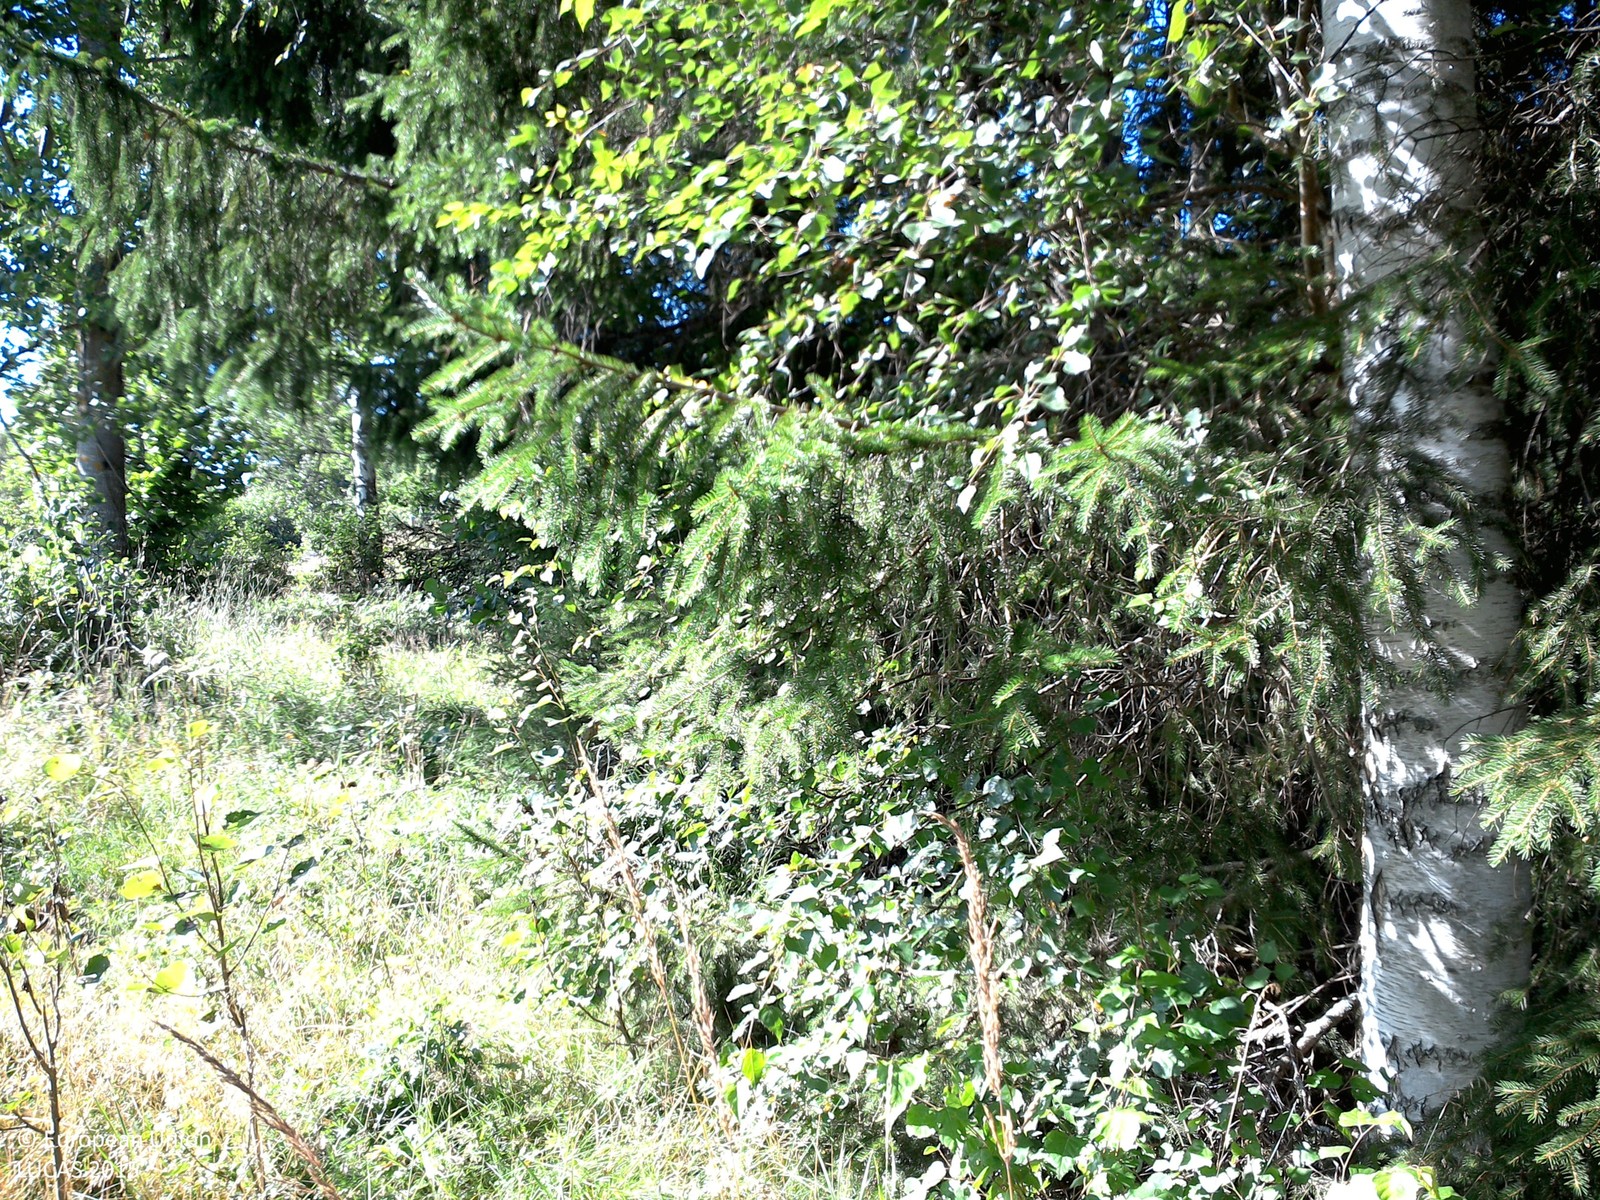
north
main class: Woodland
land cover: Broadleaved woodland
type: boreal forest
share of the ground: 50 - 75 %
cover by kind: broadleaved forest trees 55 %, herbaceous plants 40 %, coniferous forest trees 5 %
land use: Forestry
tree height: > 5 m
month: August
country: SE
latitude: 57.9604
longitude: 15.5560
